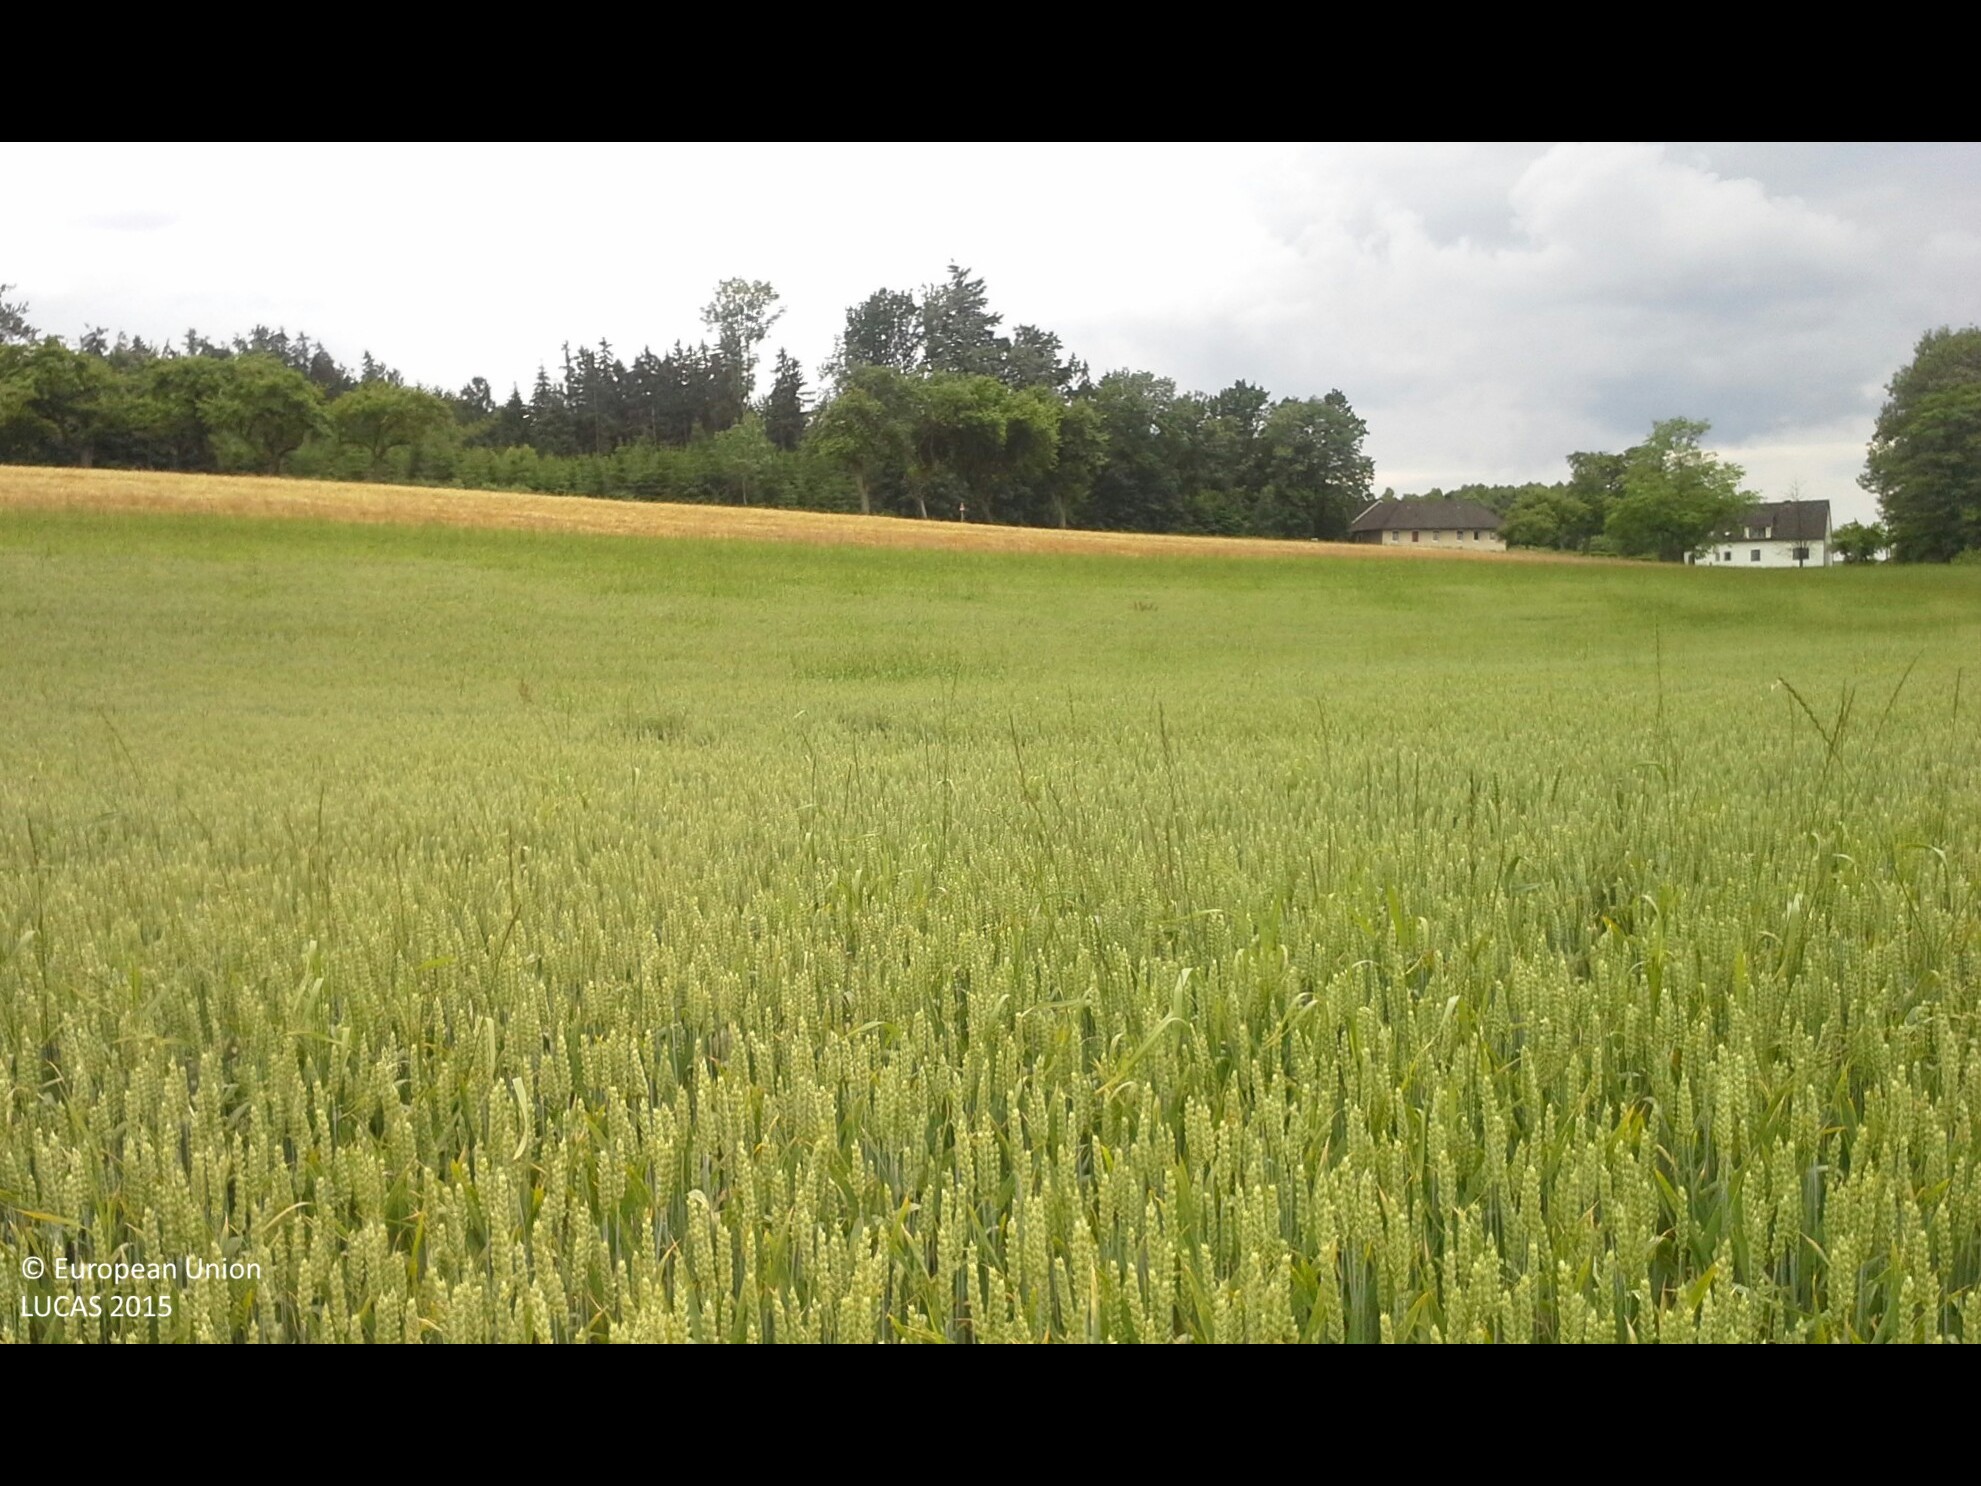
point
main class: Cropland
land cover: Triticale
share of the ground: > 75 %
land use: Agriculture (excluding fallow land and kitchen gardens)
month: June
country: AT
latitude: 48.0778
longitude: 14.4967
